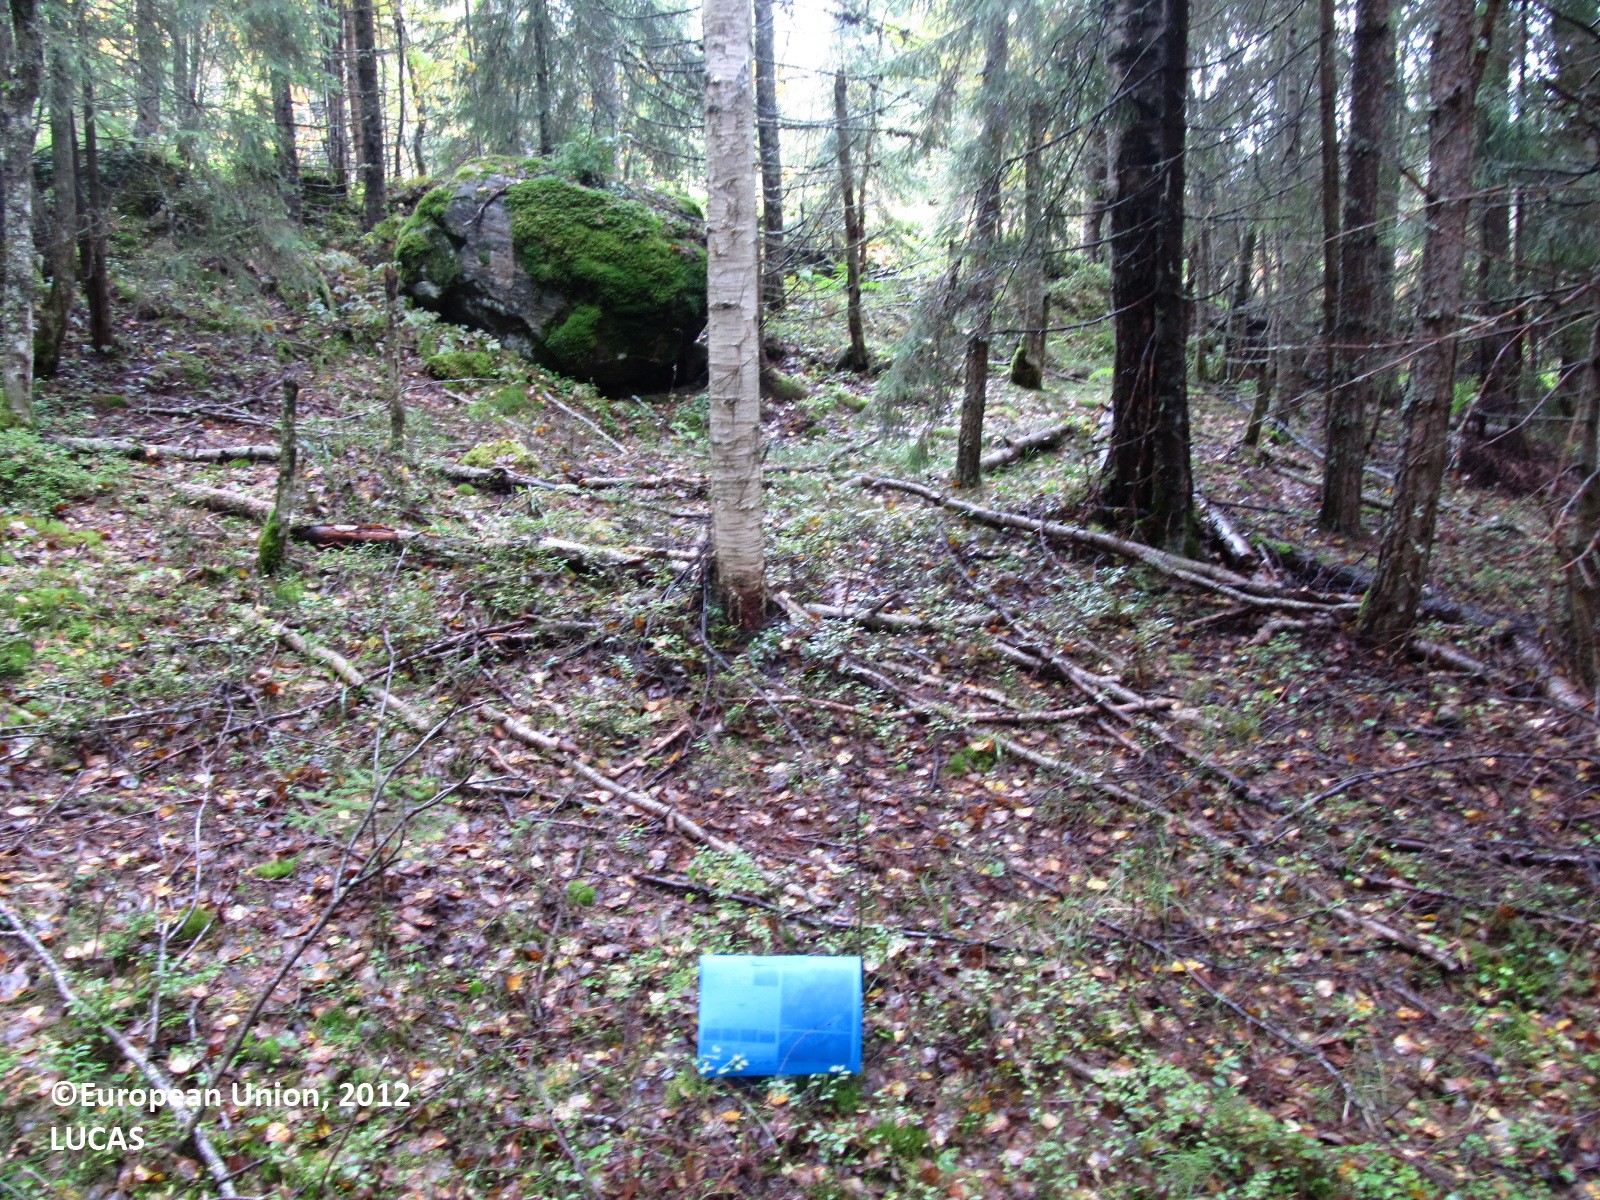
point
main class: Woodland
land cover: Spruce dominated coniferous woodland
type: boreal forest
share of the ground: 50 - 75 %
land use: Forestry
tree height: > 5 m
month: September
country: FI
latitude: 63.1986
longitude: 28.2129
